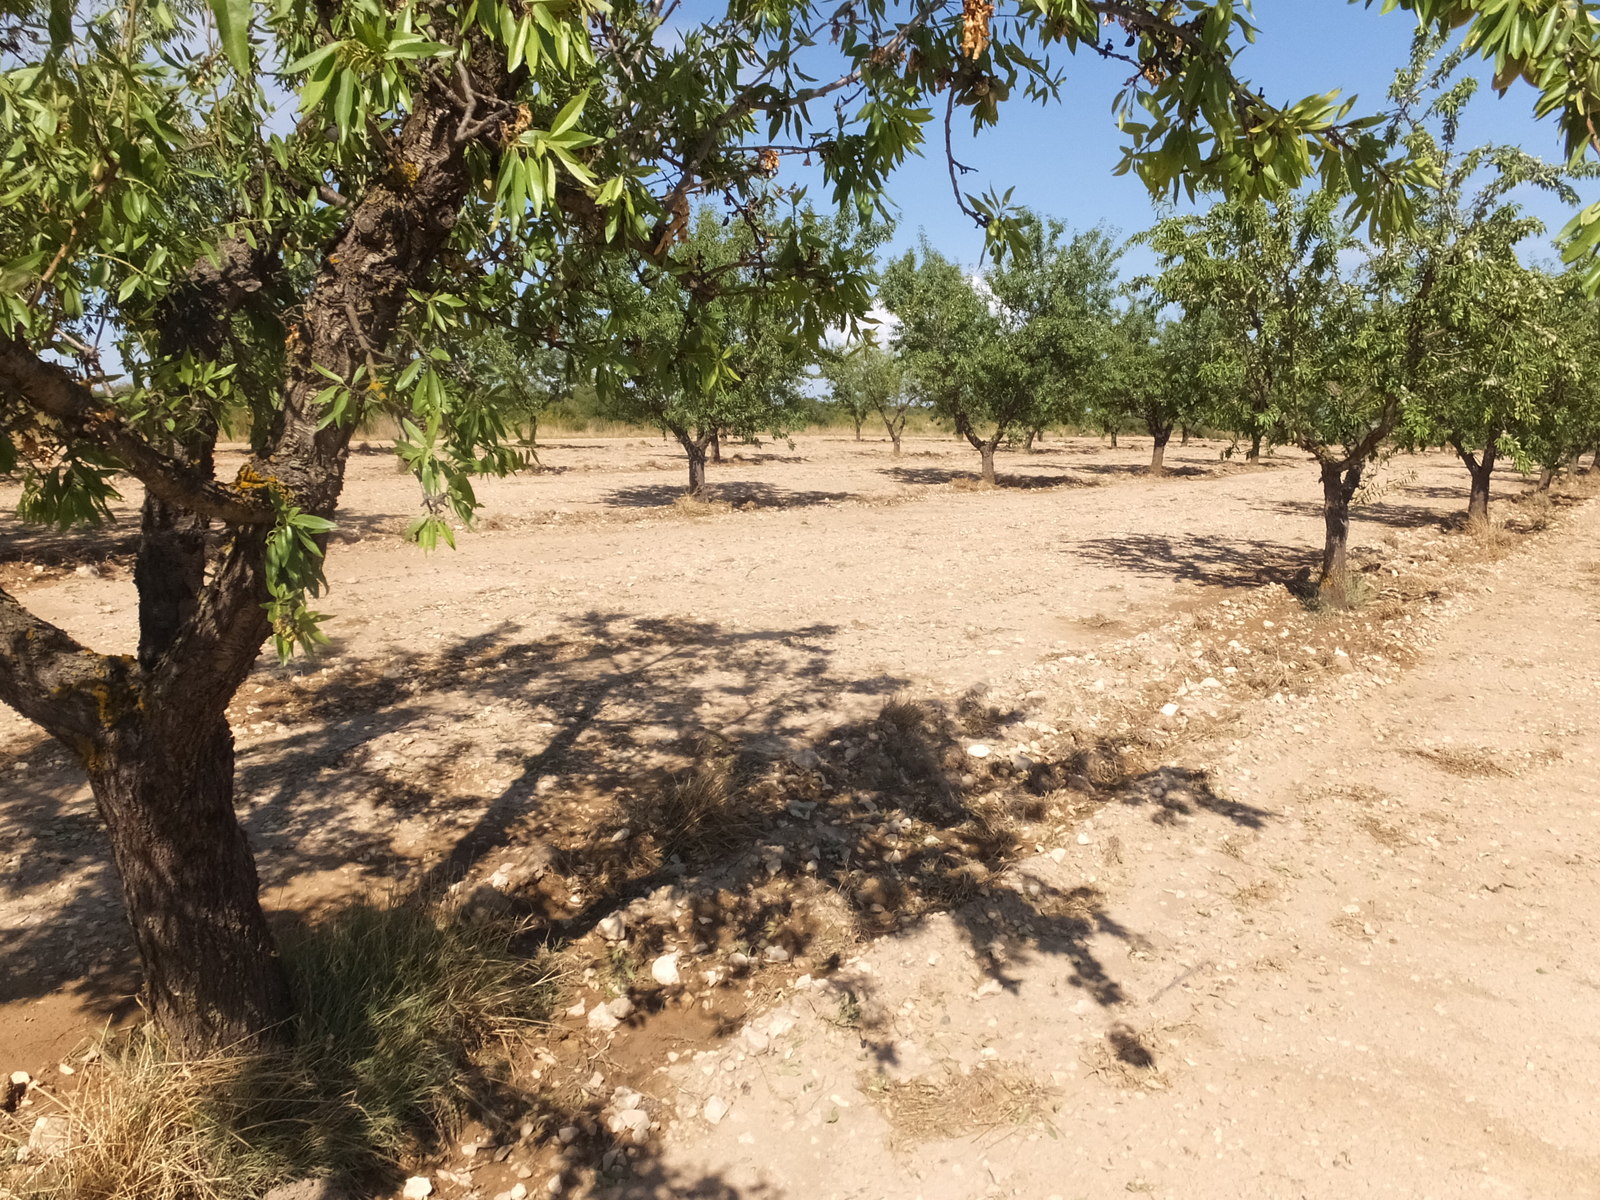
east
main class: Cropland
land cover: Nuts trees
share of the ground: > 75 %
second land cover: Other bare soil
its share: > 75 %
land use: Agriculture (excluding fallow land and kitchen gardens)
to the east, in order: Nuts trees; Other bare soil; Shruby margins; Tracks; Pine dominated mixed woodland; Tracks
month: July
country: ES
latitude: 41.1503
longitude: 0.1110
